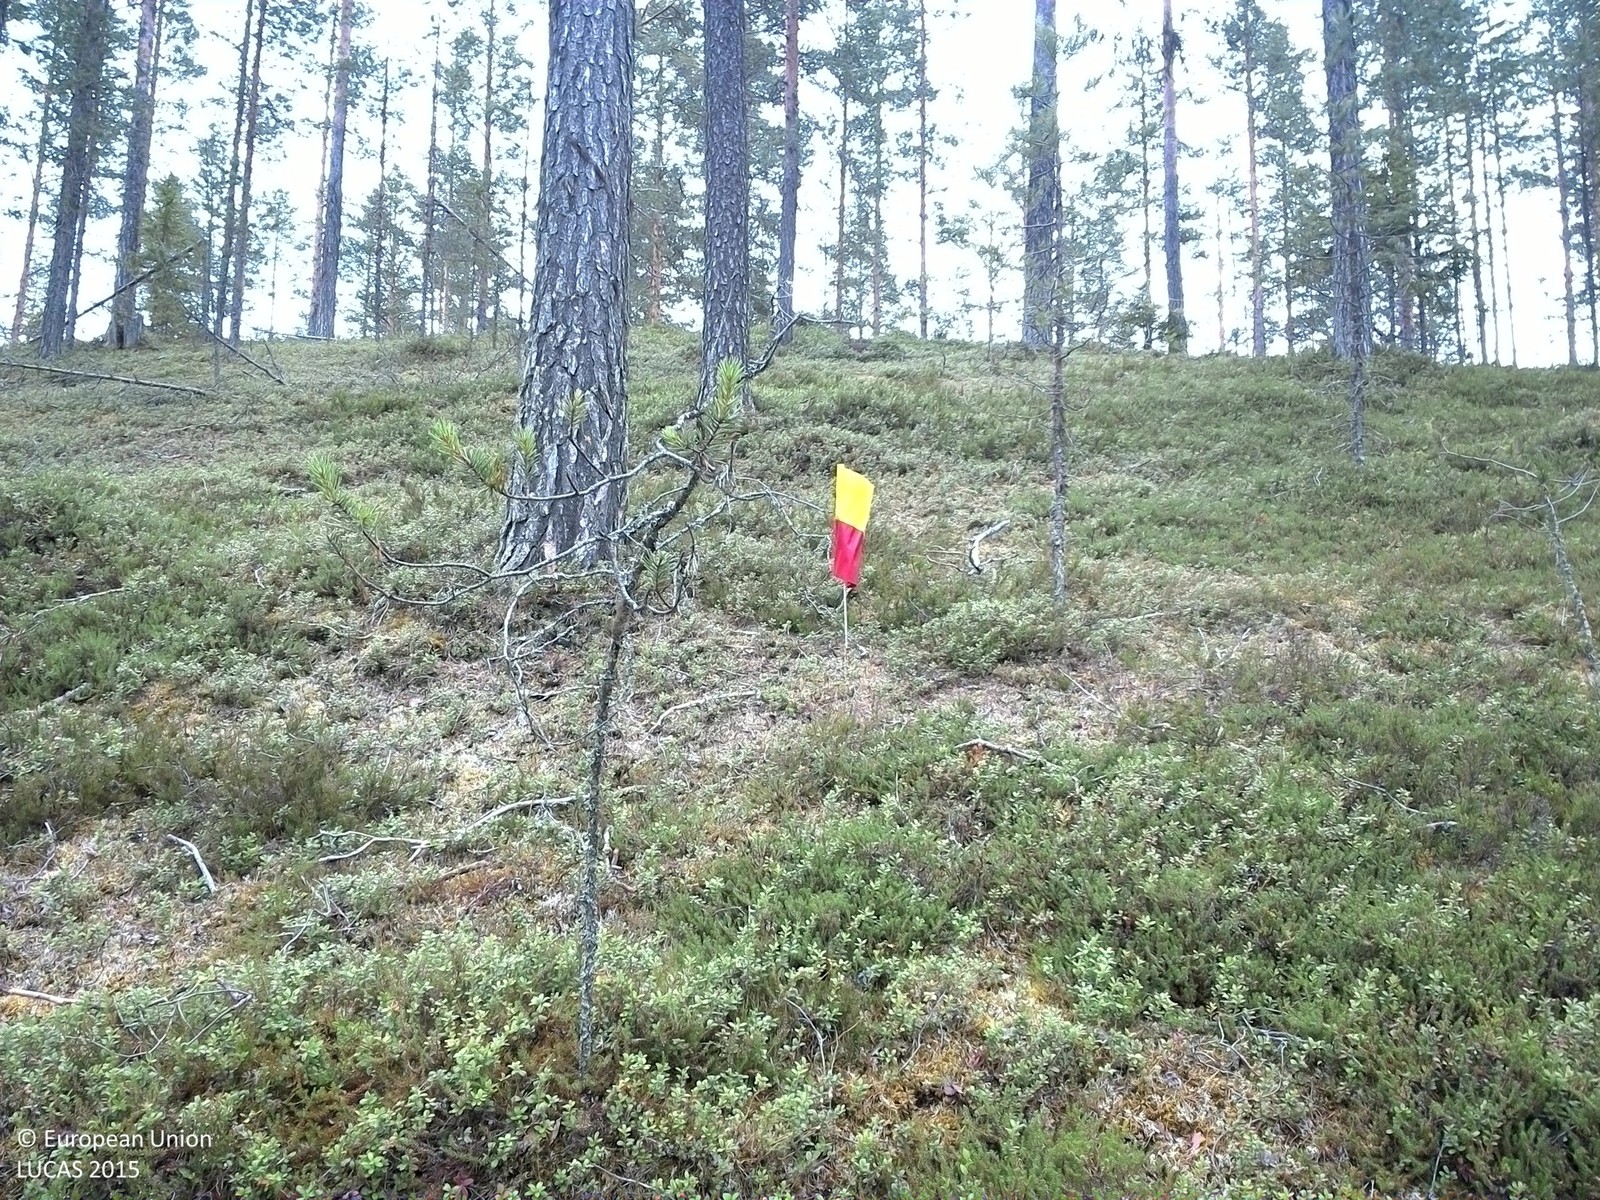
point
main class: Woodland
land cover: Pine dominated coniferous woodland
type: boreal forest
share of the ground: 25 - 50 %
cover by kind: shrubs 50 %, coniferous forest trees 25 %, lichens and mosses 25 %
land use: Forestry
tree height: > 5 m
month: August
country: SE
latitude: 63.6891
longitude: 17.2321
